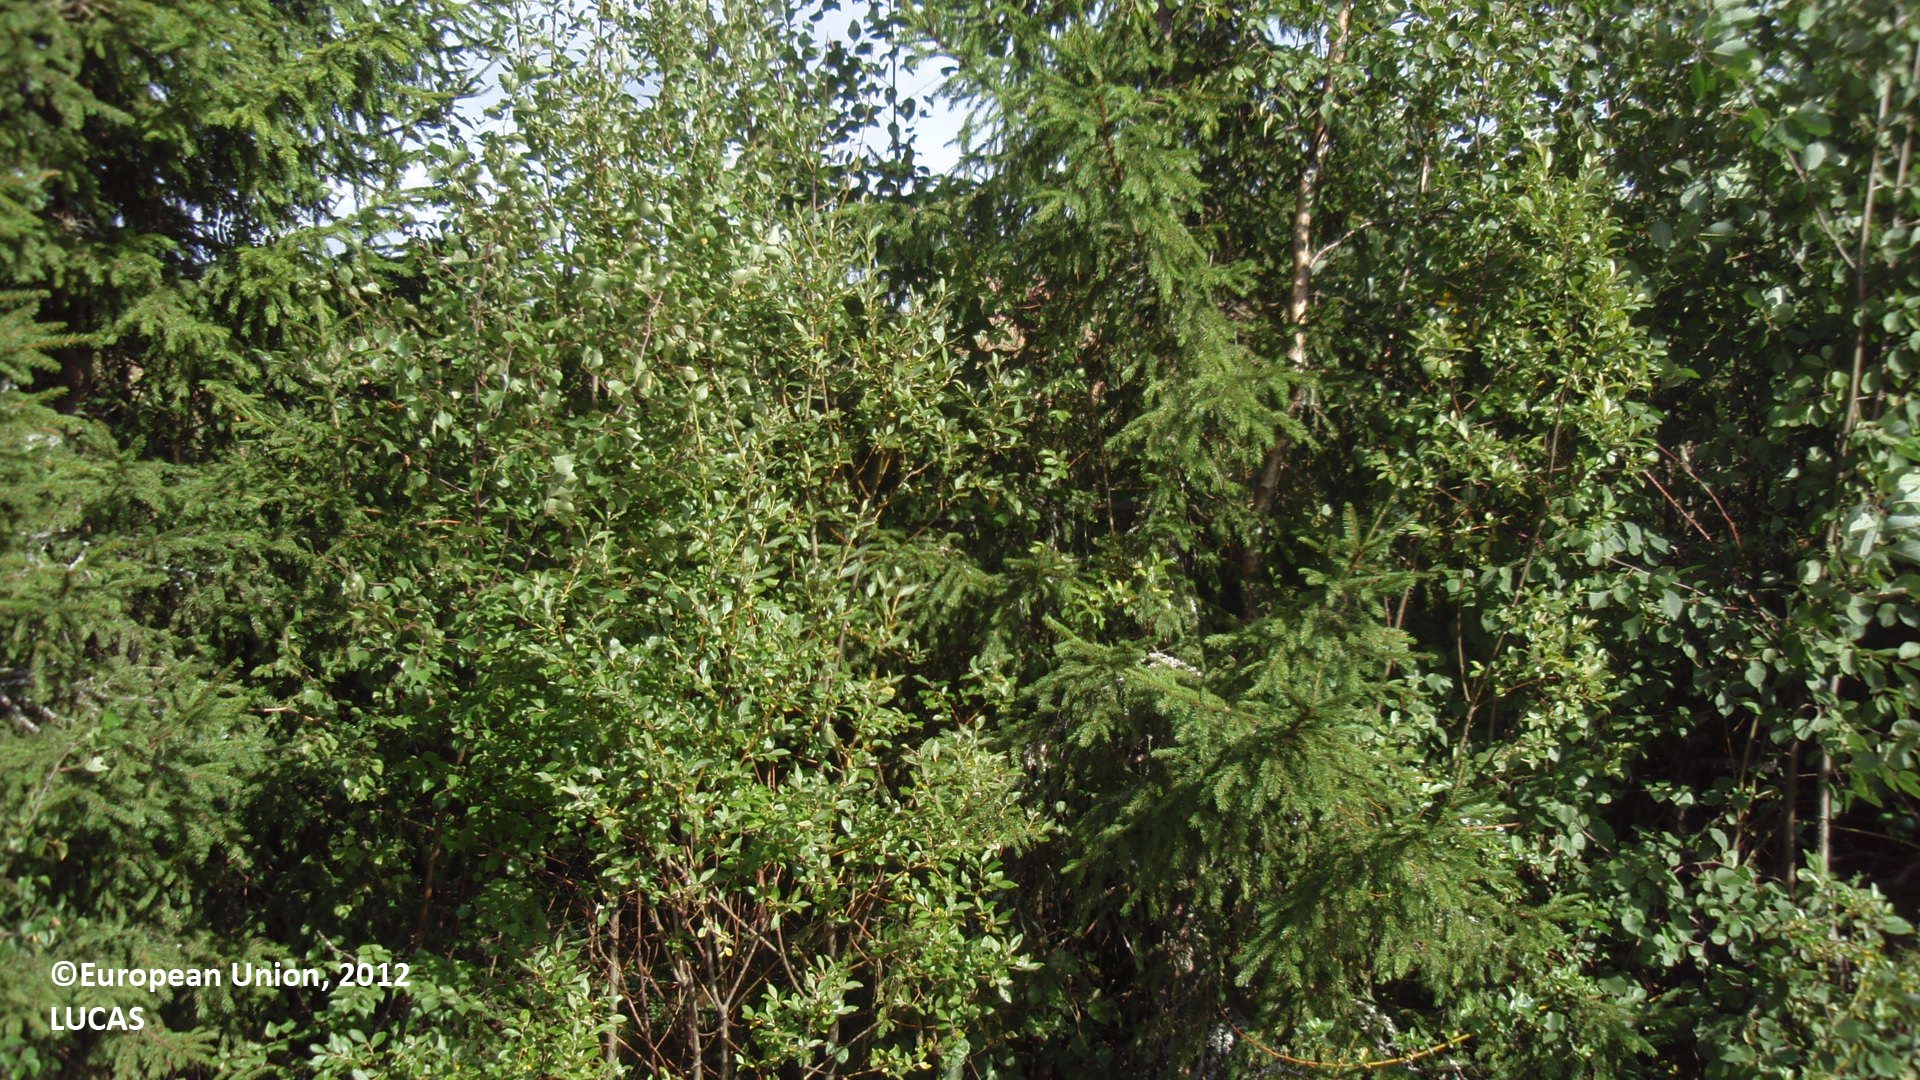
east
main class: Cropland
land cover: Oats
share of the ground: > 75 %
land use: Agriculture (excluding fallow land and kitchen gardens)
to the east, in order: Oats; Grass margins; Ditches and canals; Shrubland with sparse tree cover; Grassland with sparse tree/shrub cover; Paved roads, cycling and walking lanes; Grassland with sparse tree/shrub cover; Tracks; Spruce dominated coniferous woodland; Pine dominated mixed woodland
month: August
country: FI
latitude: 61.0506
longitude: 27.0775
